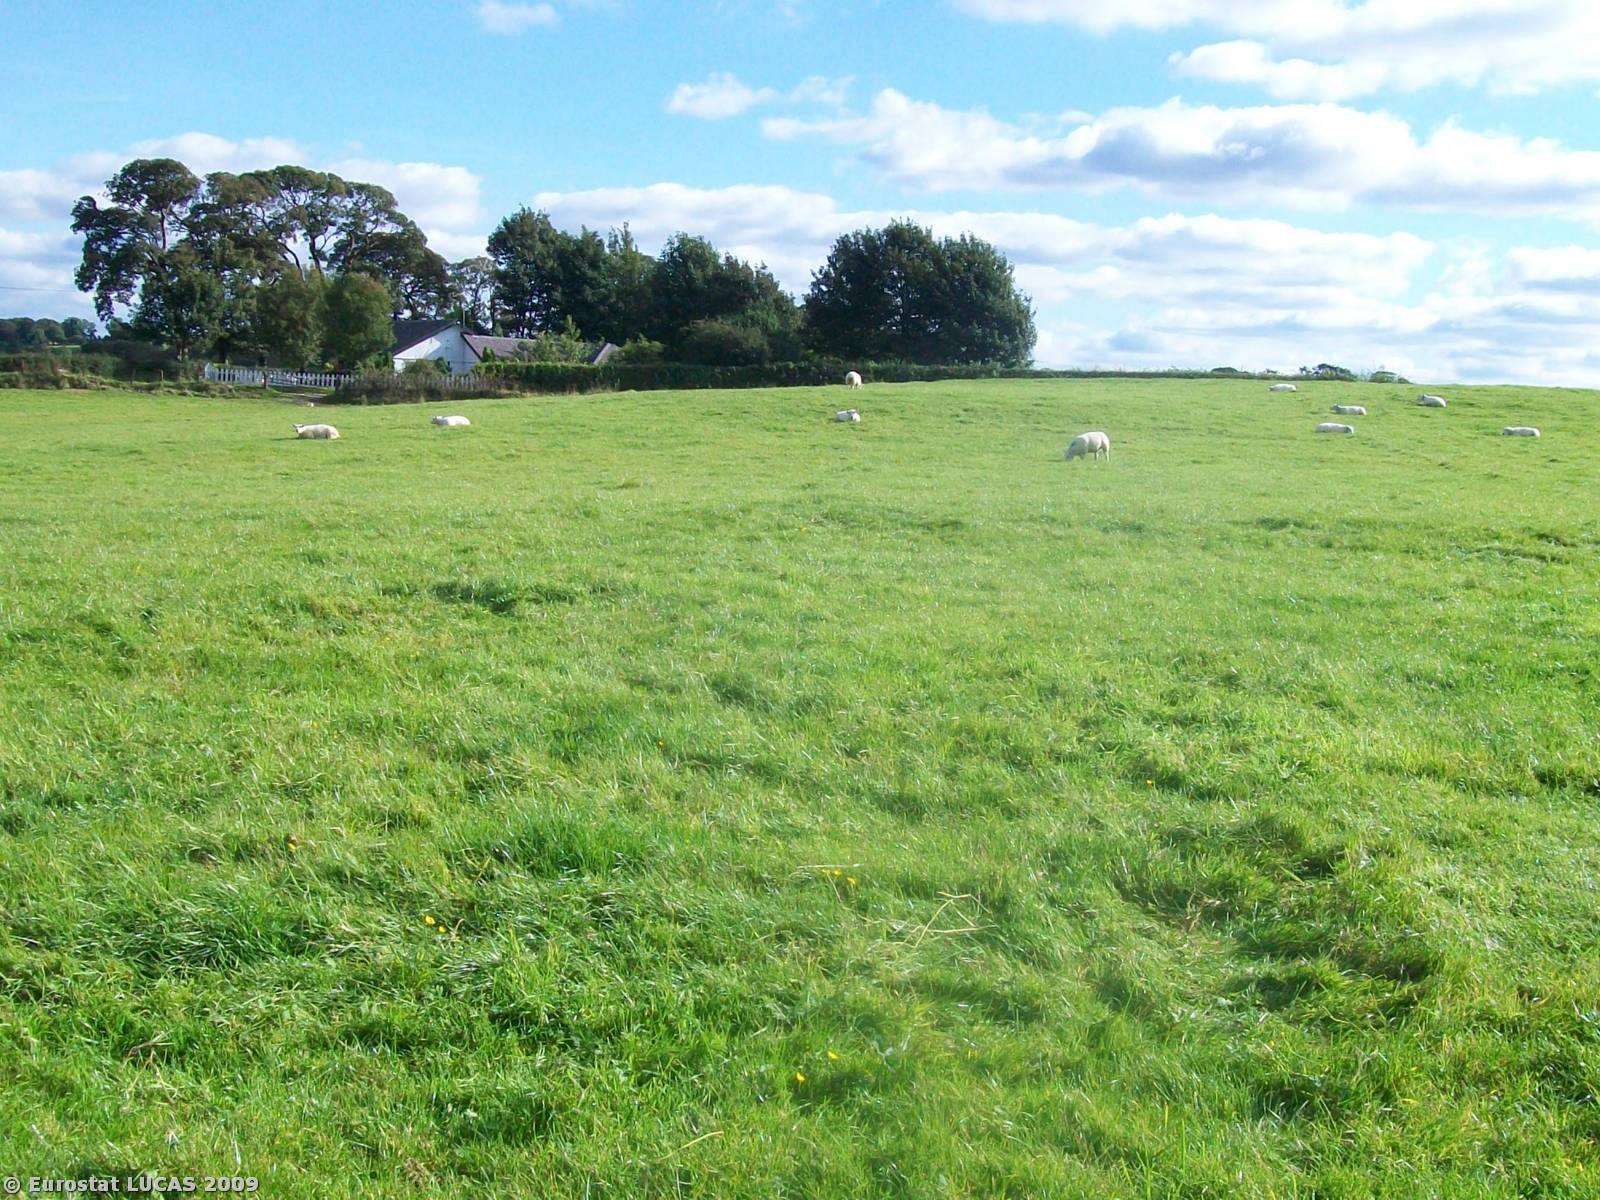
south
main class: Grassland
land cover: Grassland without tree/shrub cover
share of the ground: < 10 %
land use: Agriculture (excluding fallow land and kitchen gardens)
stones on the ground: 10 - 25 %
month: September
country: GB
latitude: 55.7761
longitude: -4.3646
